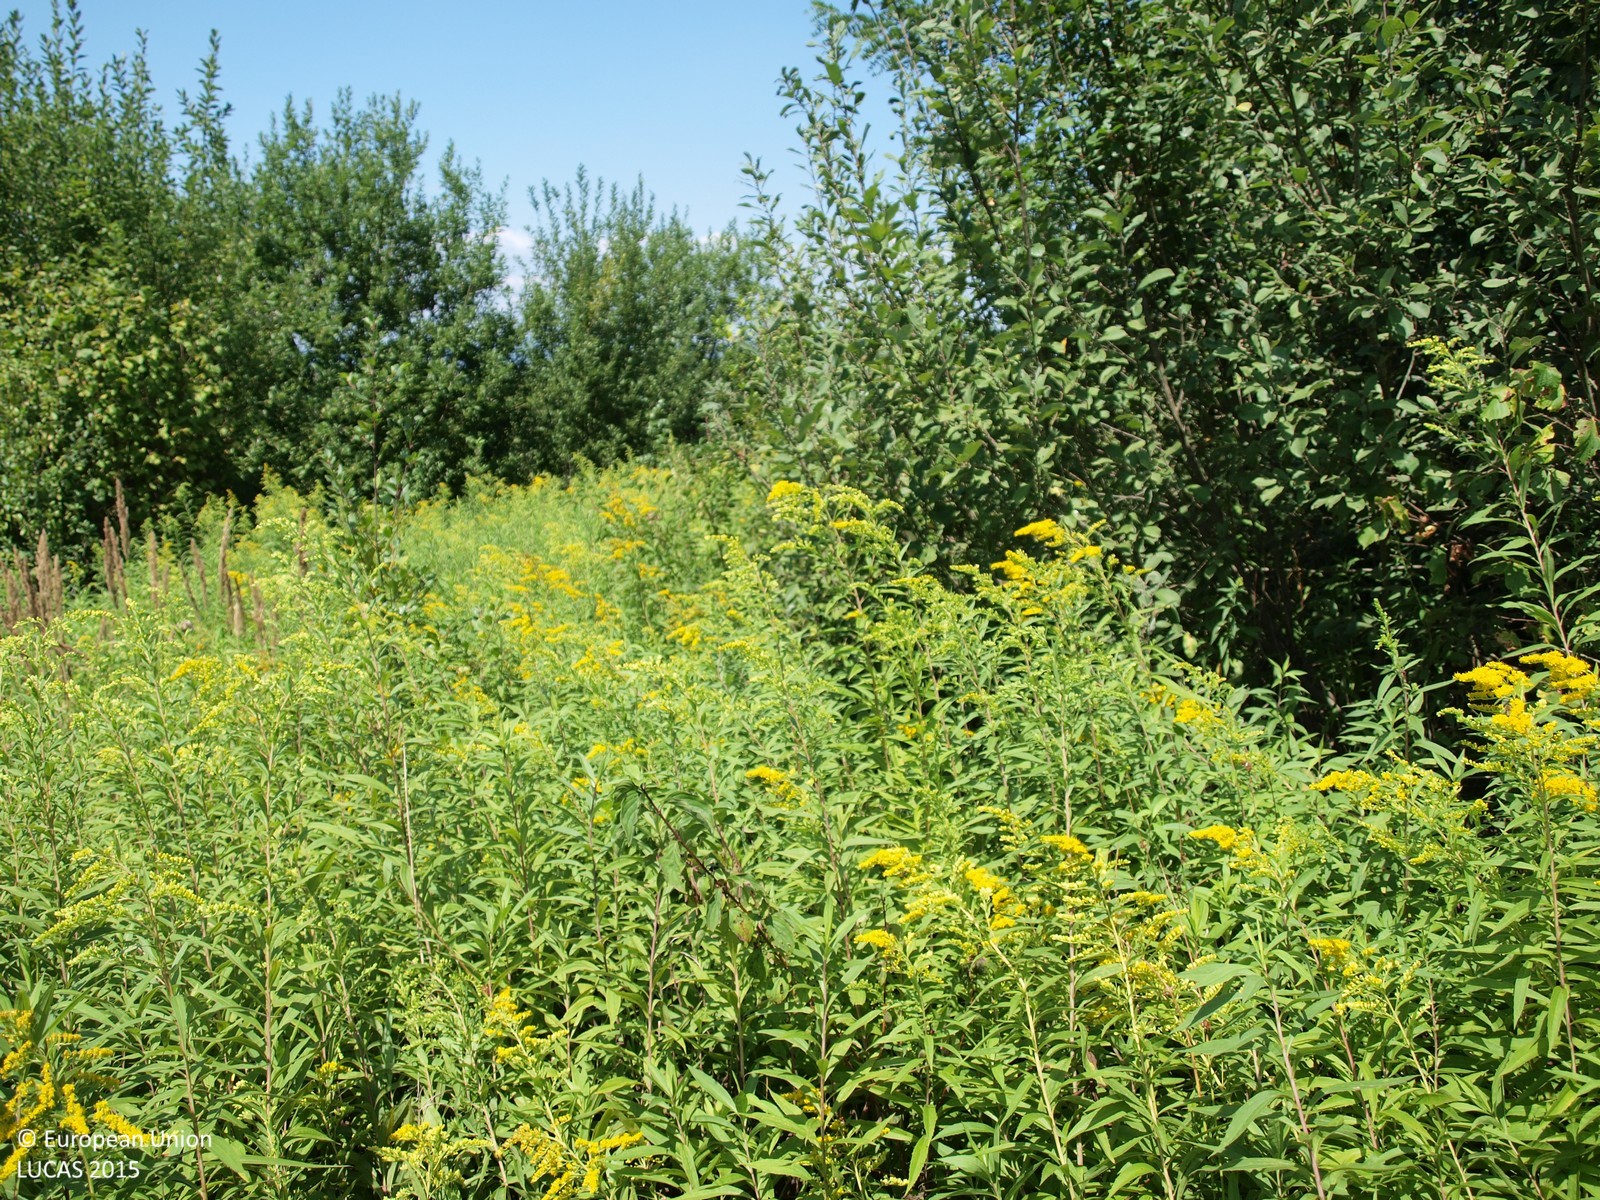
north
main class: Shrubland
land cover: Shrubland with sparse tree cover
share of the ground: > 75 %
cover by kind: shrubs 95 %, broadleaved forest trees 5 %
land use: Abandoned areas
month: August
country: HR
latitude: 45.8616
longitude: 16.2456
